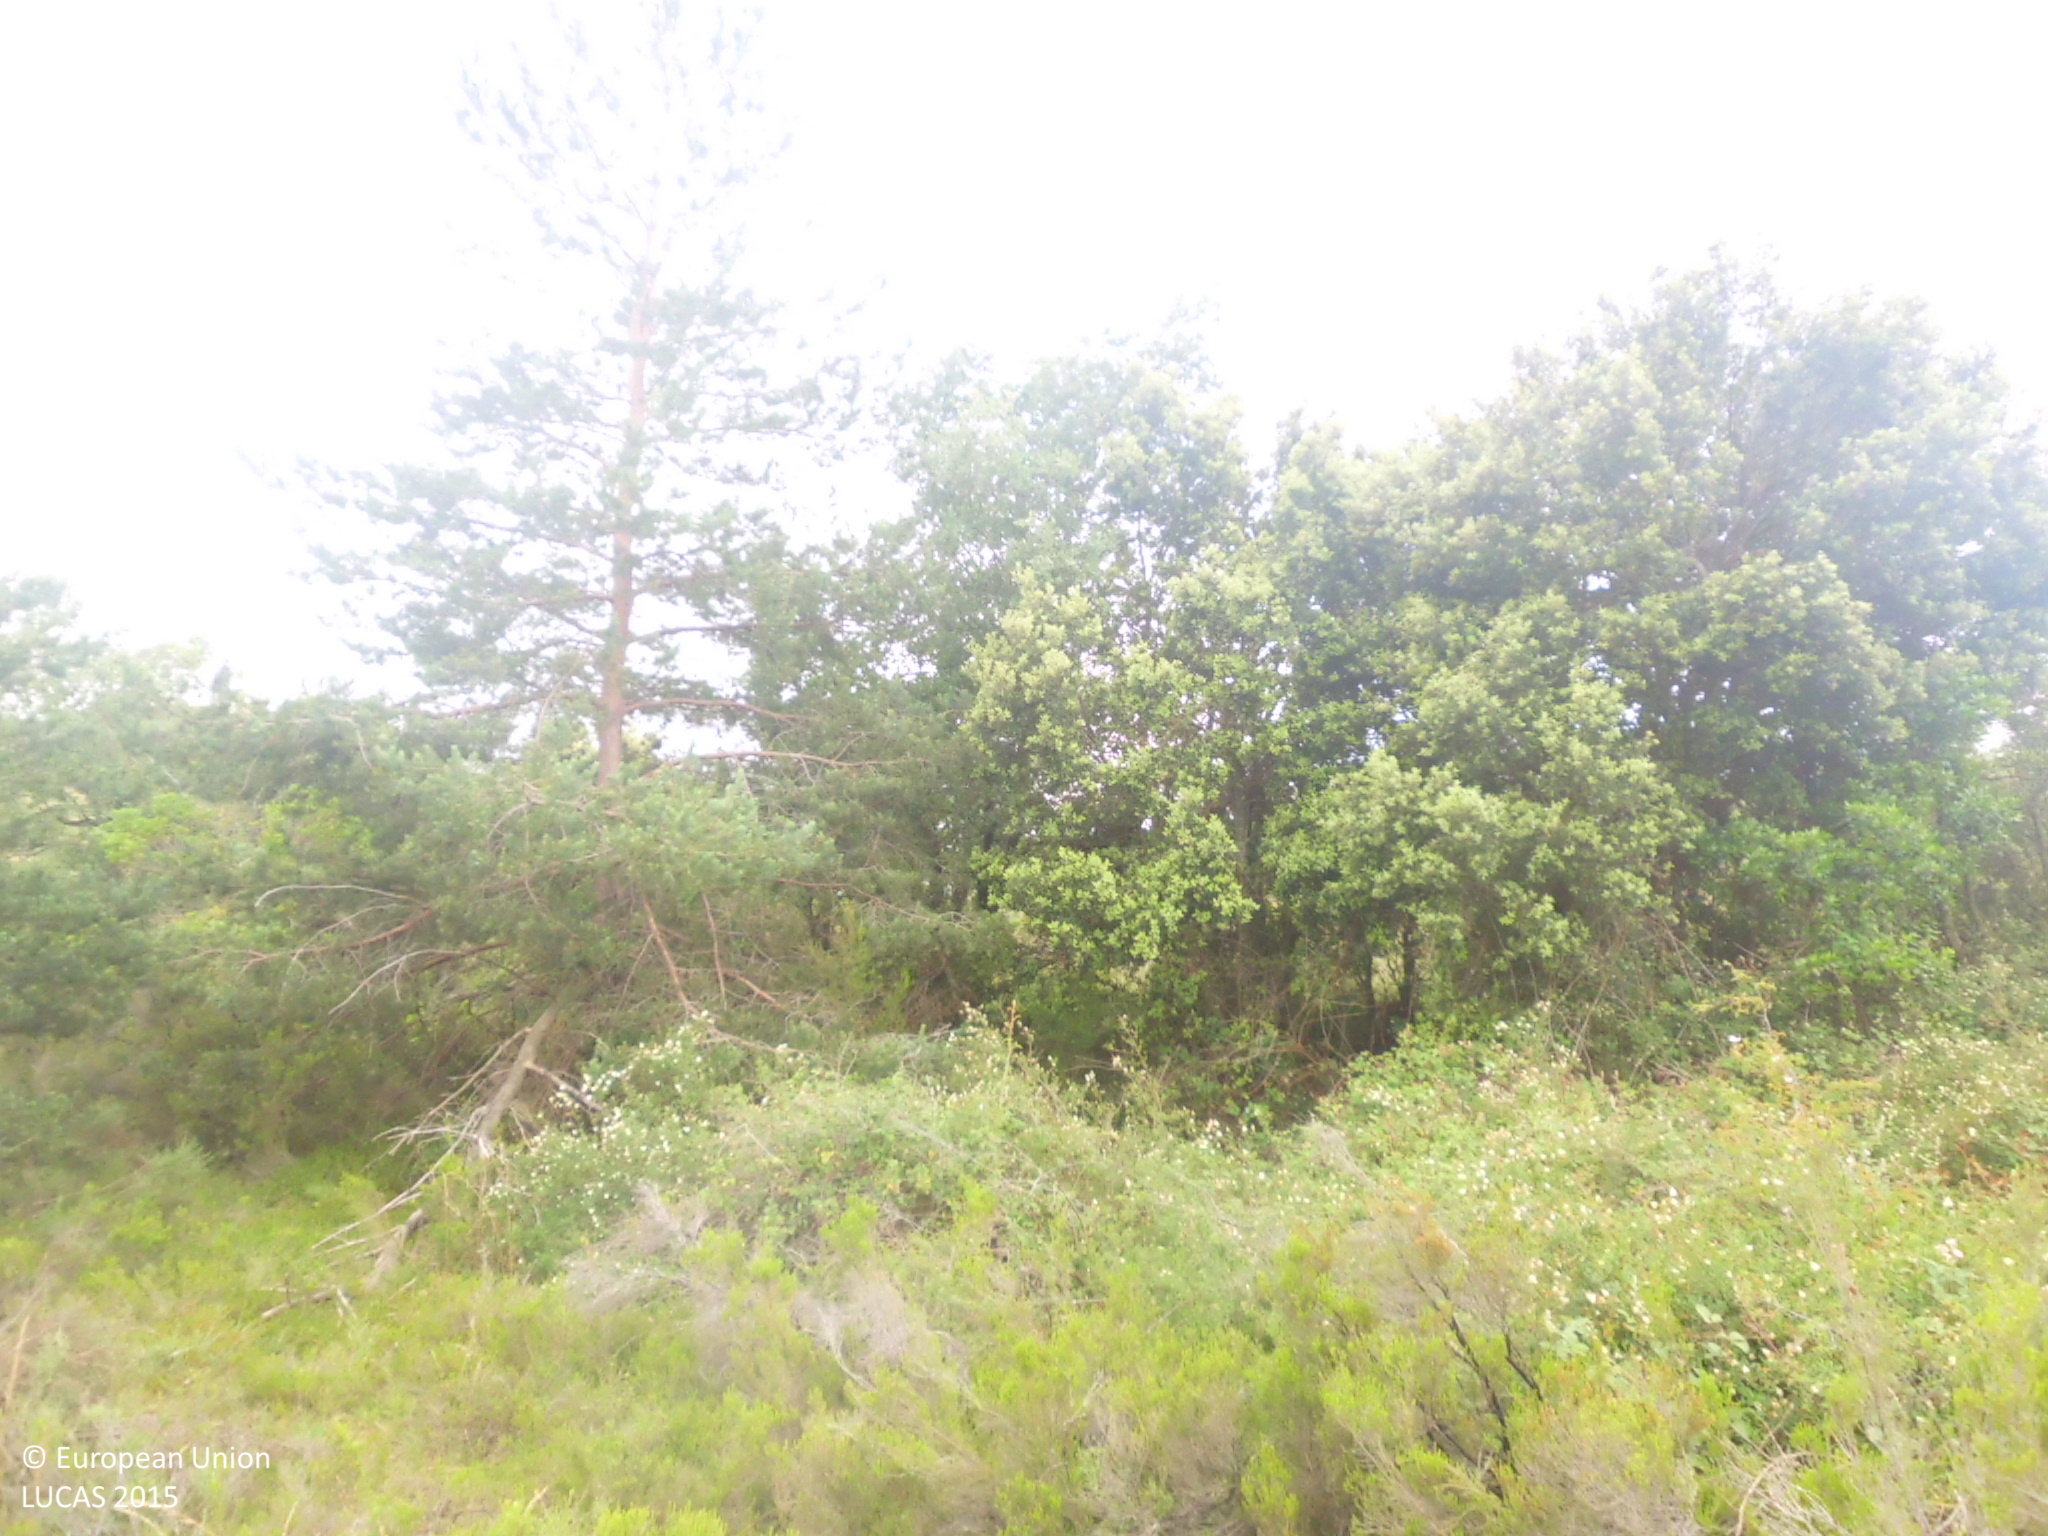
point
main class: Woodland
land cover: Broadleaved woodland
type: acidophilous oak and oak-birch forest
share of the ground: > 75 %
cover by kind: broadleaved forest trees 75 %, shrubs 25 %
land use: Semi-natural and natural areas not in use
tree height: > 5 m
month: June
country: ES
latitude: 42.7293
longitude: -3.1120
